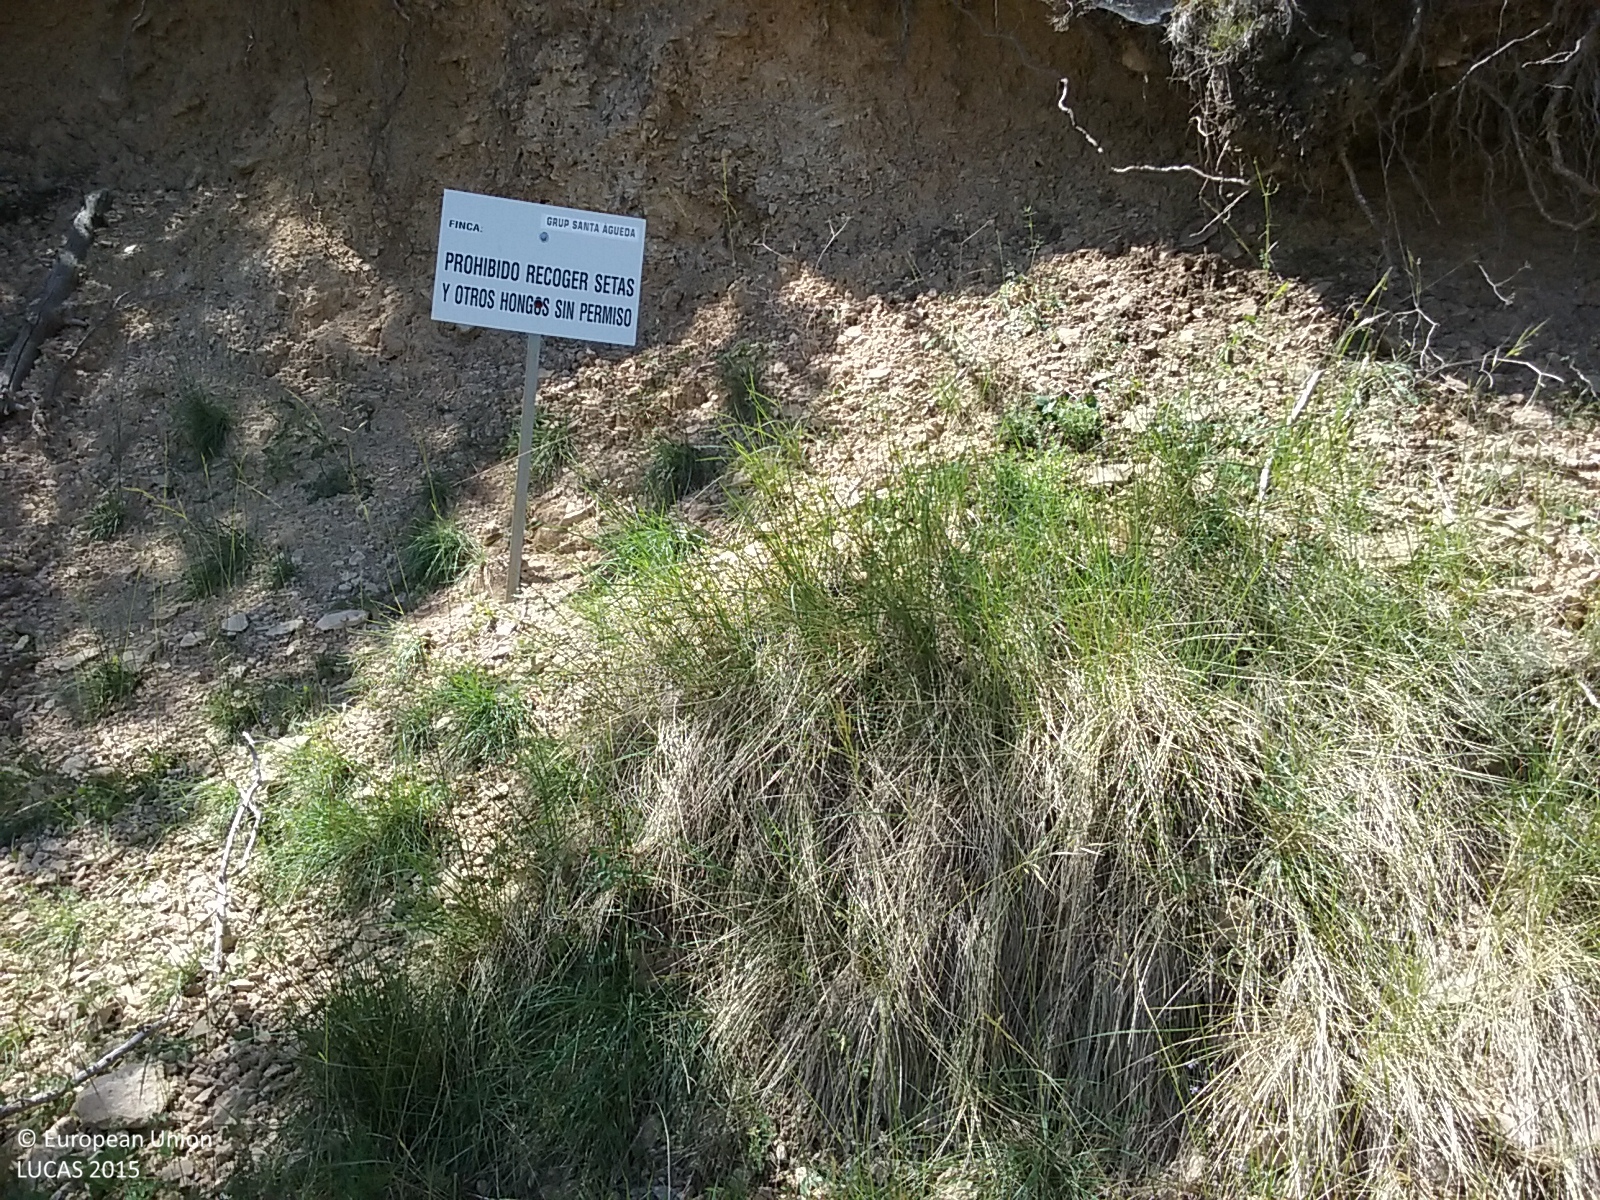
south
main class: Woodland
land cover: Pine dominated coniferous woodland
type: coniferous forest of the mediterranean region
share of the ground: 25 - 50 %
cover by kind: unconsolidated bare surface 70 %, coniferous forest trees 30 %
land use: Semi-natural and natural areas not in use
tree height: > 5 m
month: June
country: ES
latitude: 40.5784
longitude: 0.0349
